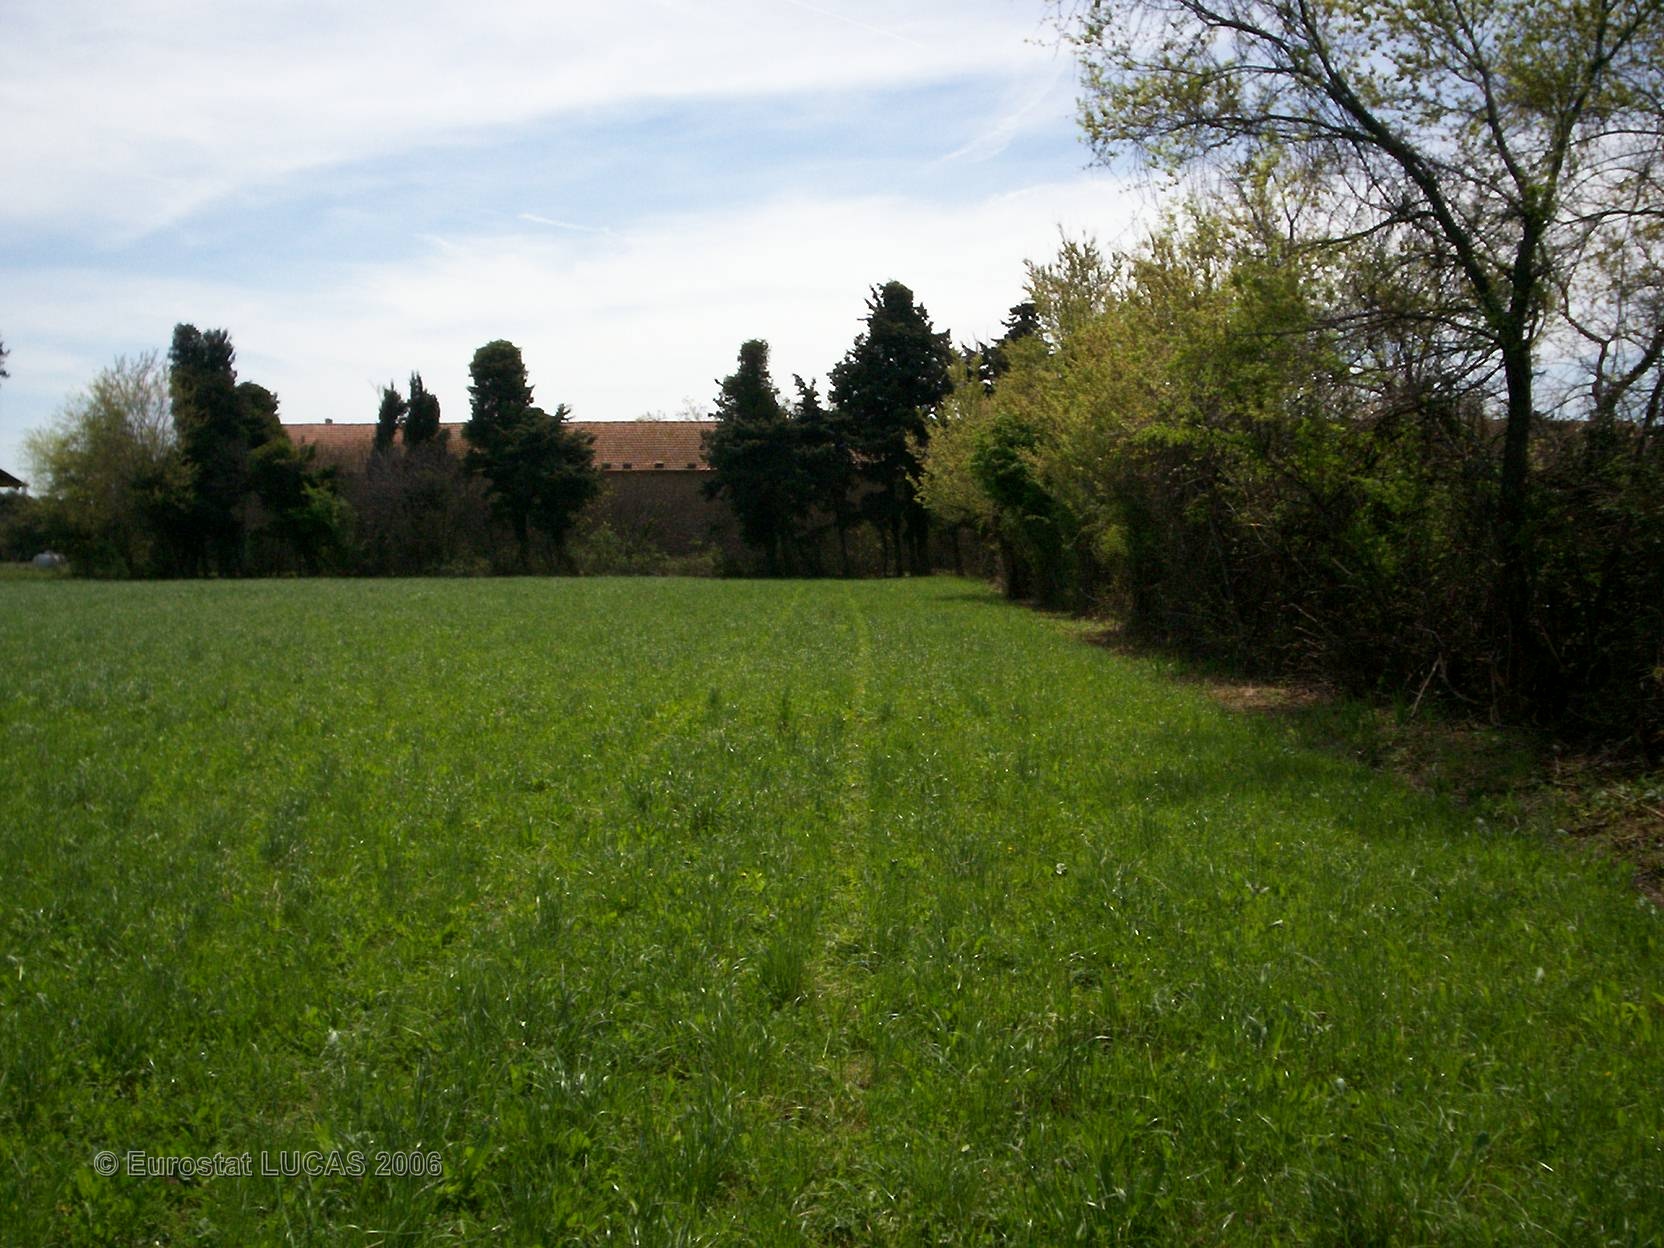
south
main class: Grassland
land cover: Grassland without tree/shrub cover
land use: Agriculture (excluding fallow land and kitchen gardens)
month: April
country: FR
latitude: 43.6835
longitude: 4.9109
